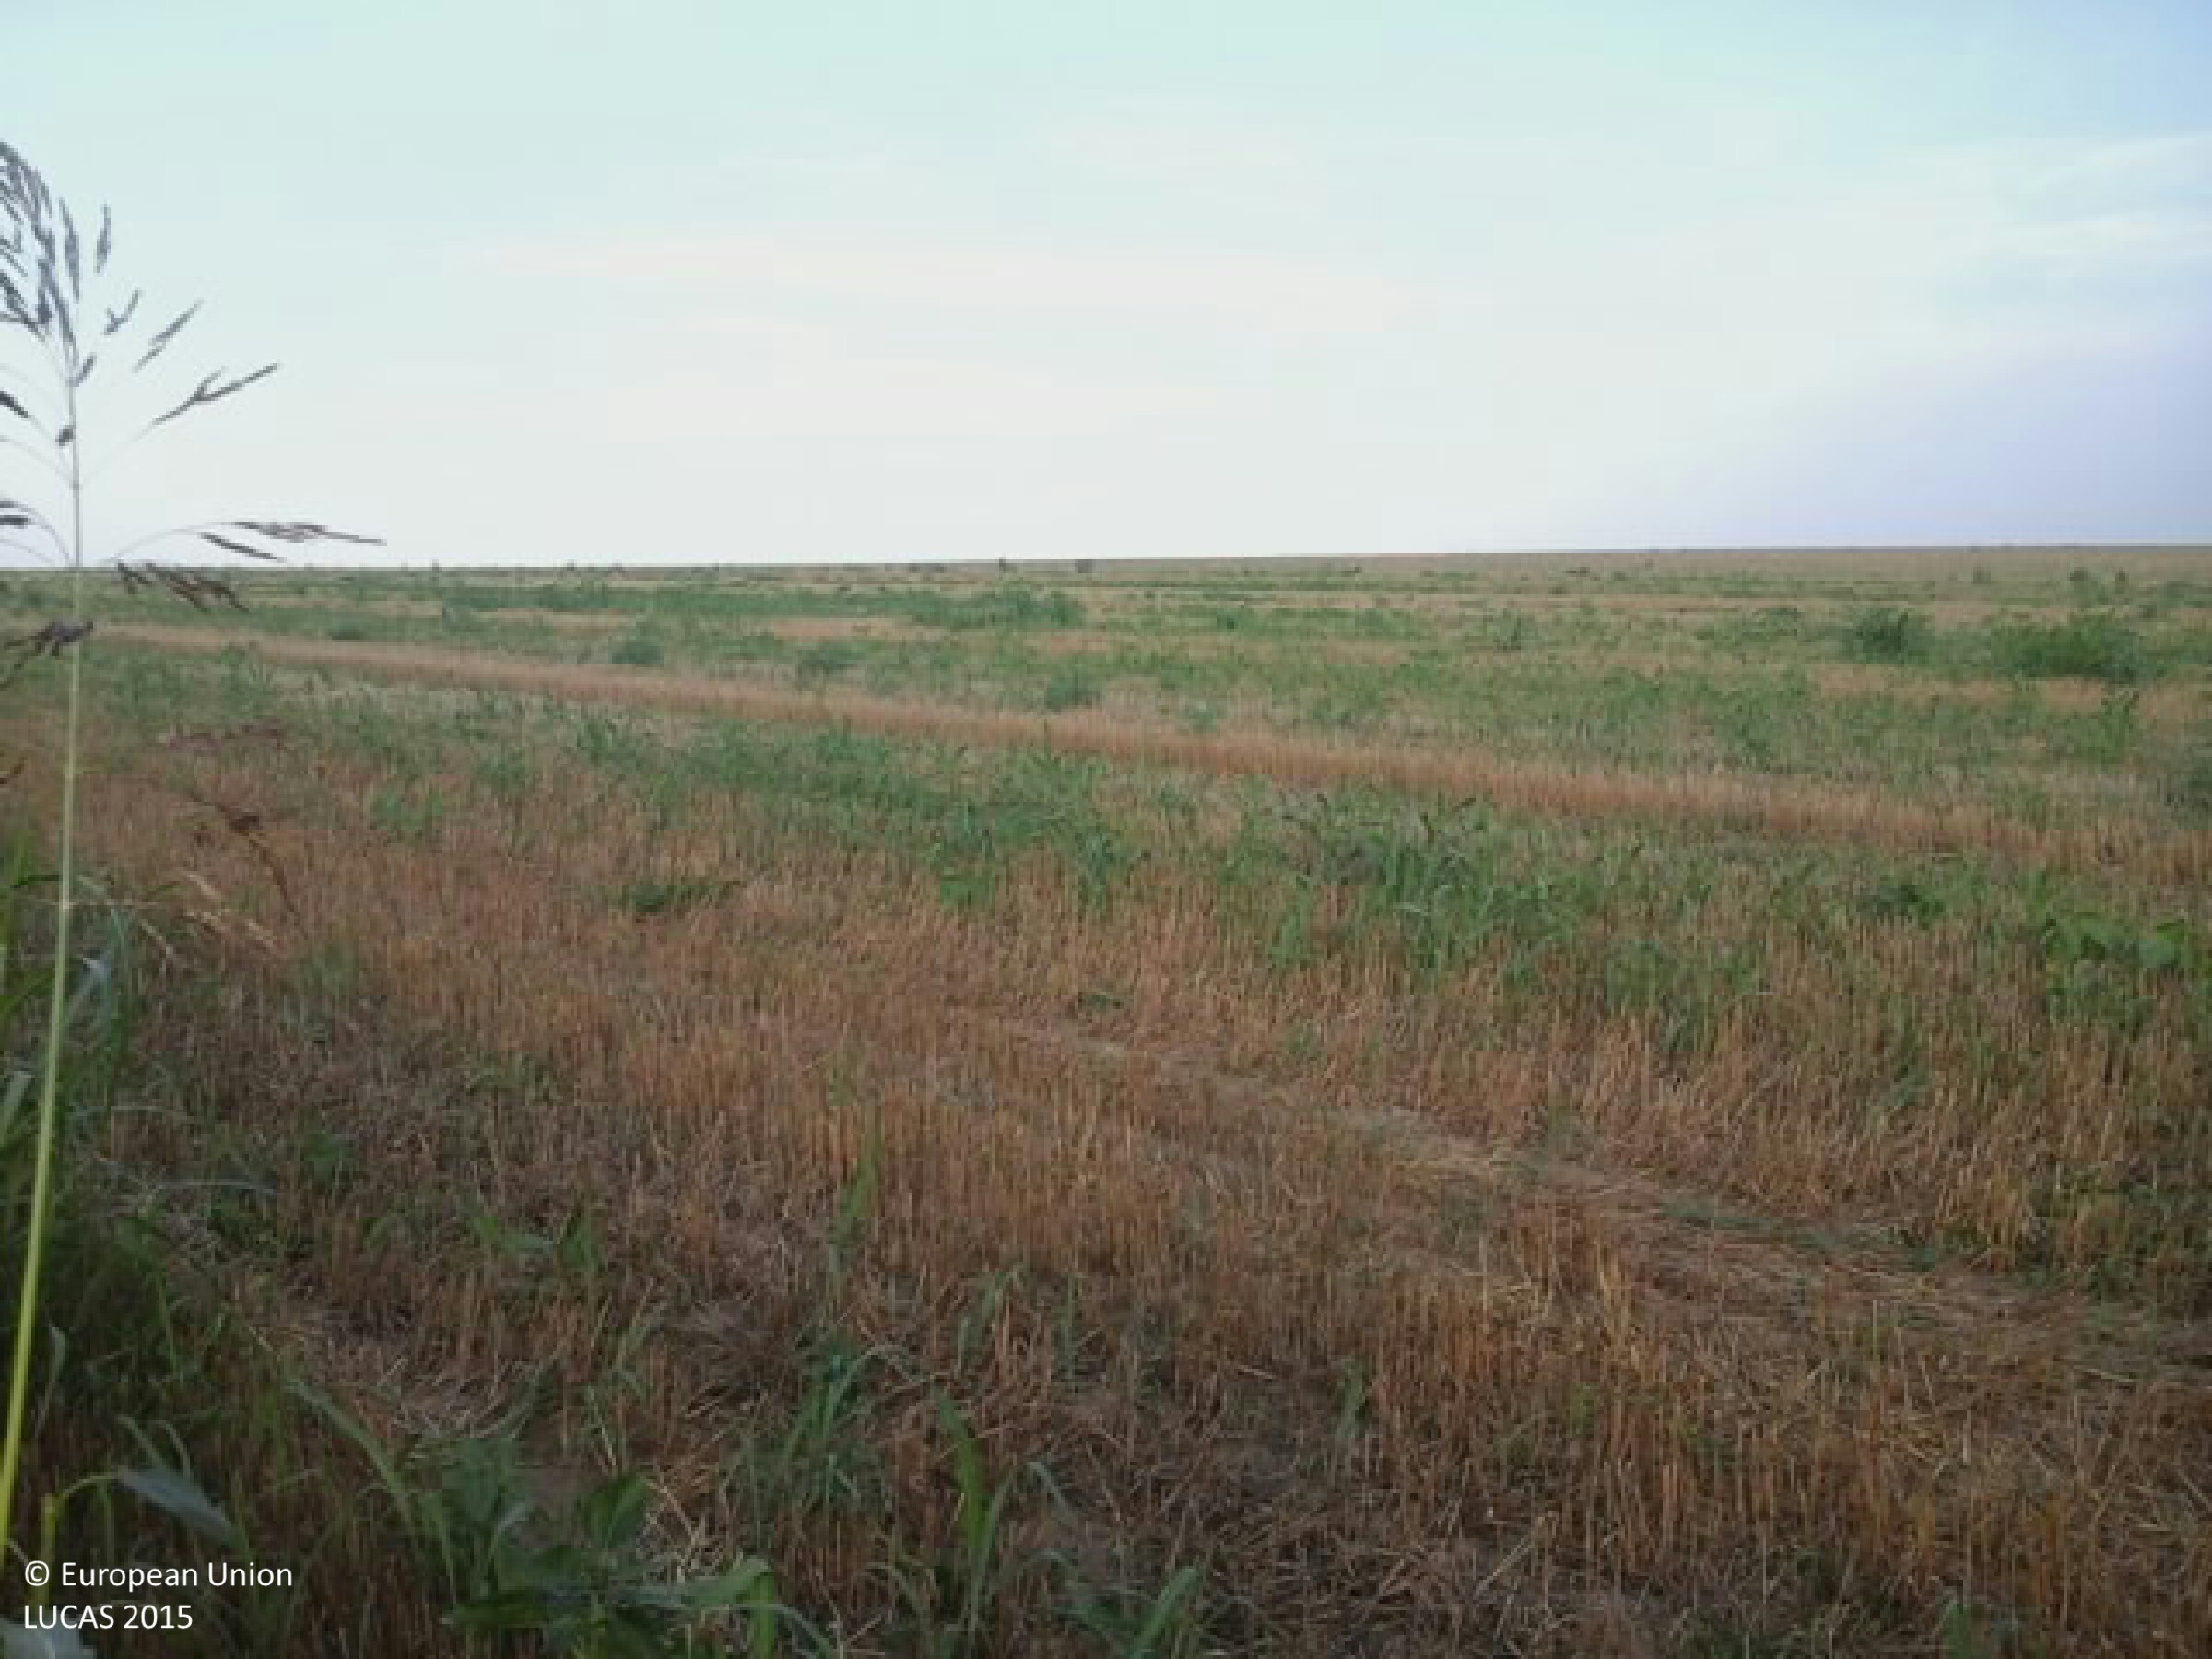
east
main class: Cropland
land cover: Sunflower
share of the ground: > 75 %
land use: Agriculture (excluding fallow land and kitchen gardens)
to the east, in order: Sunflower; Common wheat
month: August
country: HU
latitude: 46.6870
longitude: 18.2073
